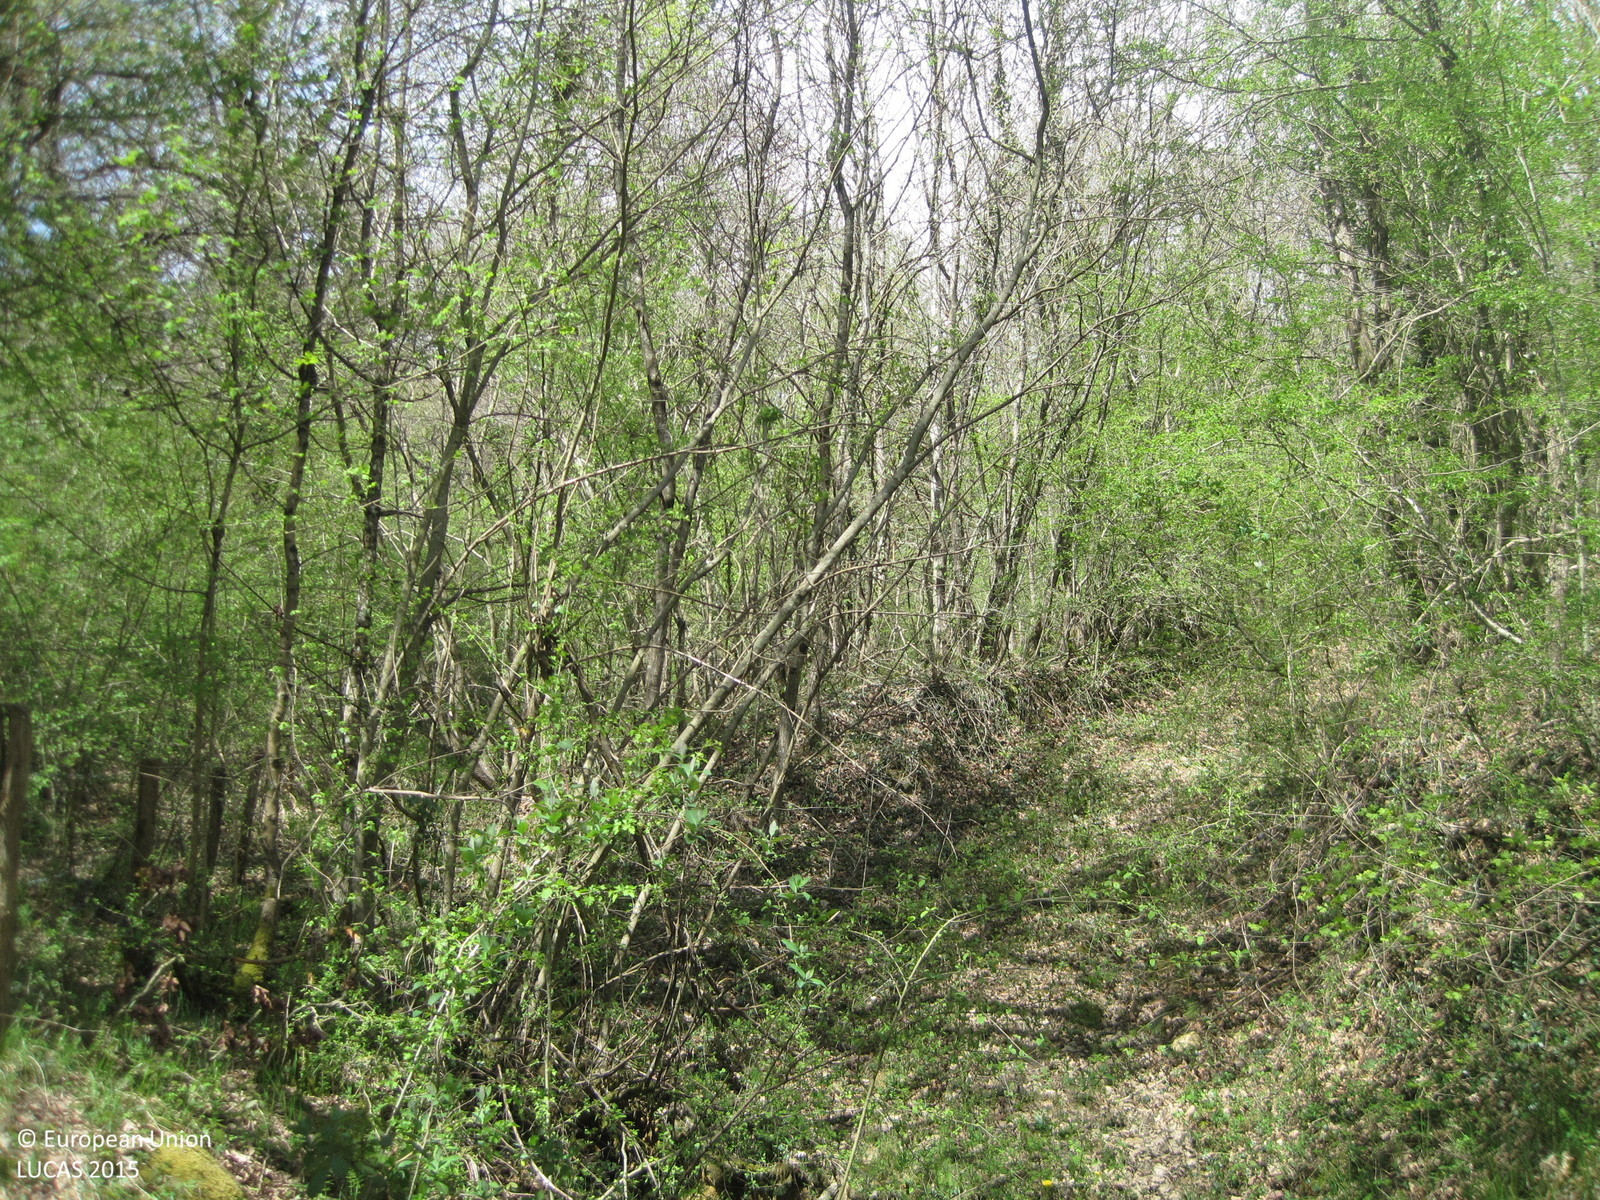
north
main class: Woodland
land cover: Broadleaved woodland
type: acidophilous oak and oak-birch forest
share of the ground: > 75 %
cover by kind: broadleaved forest trees 100 %
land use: Forestry
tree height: > 5 m
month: April
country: ES
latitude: 42.8770
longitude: -2.2272
